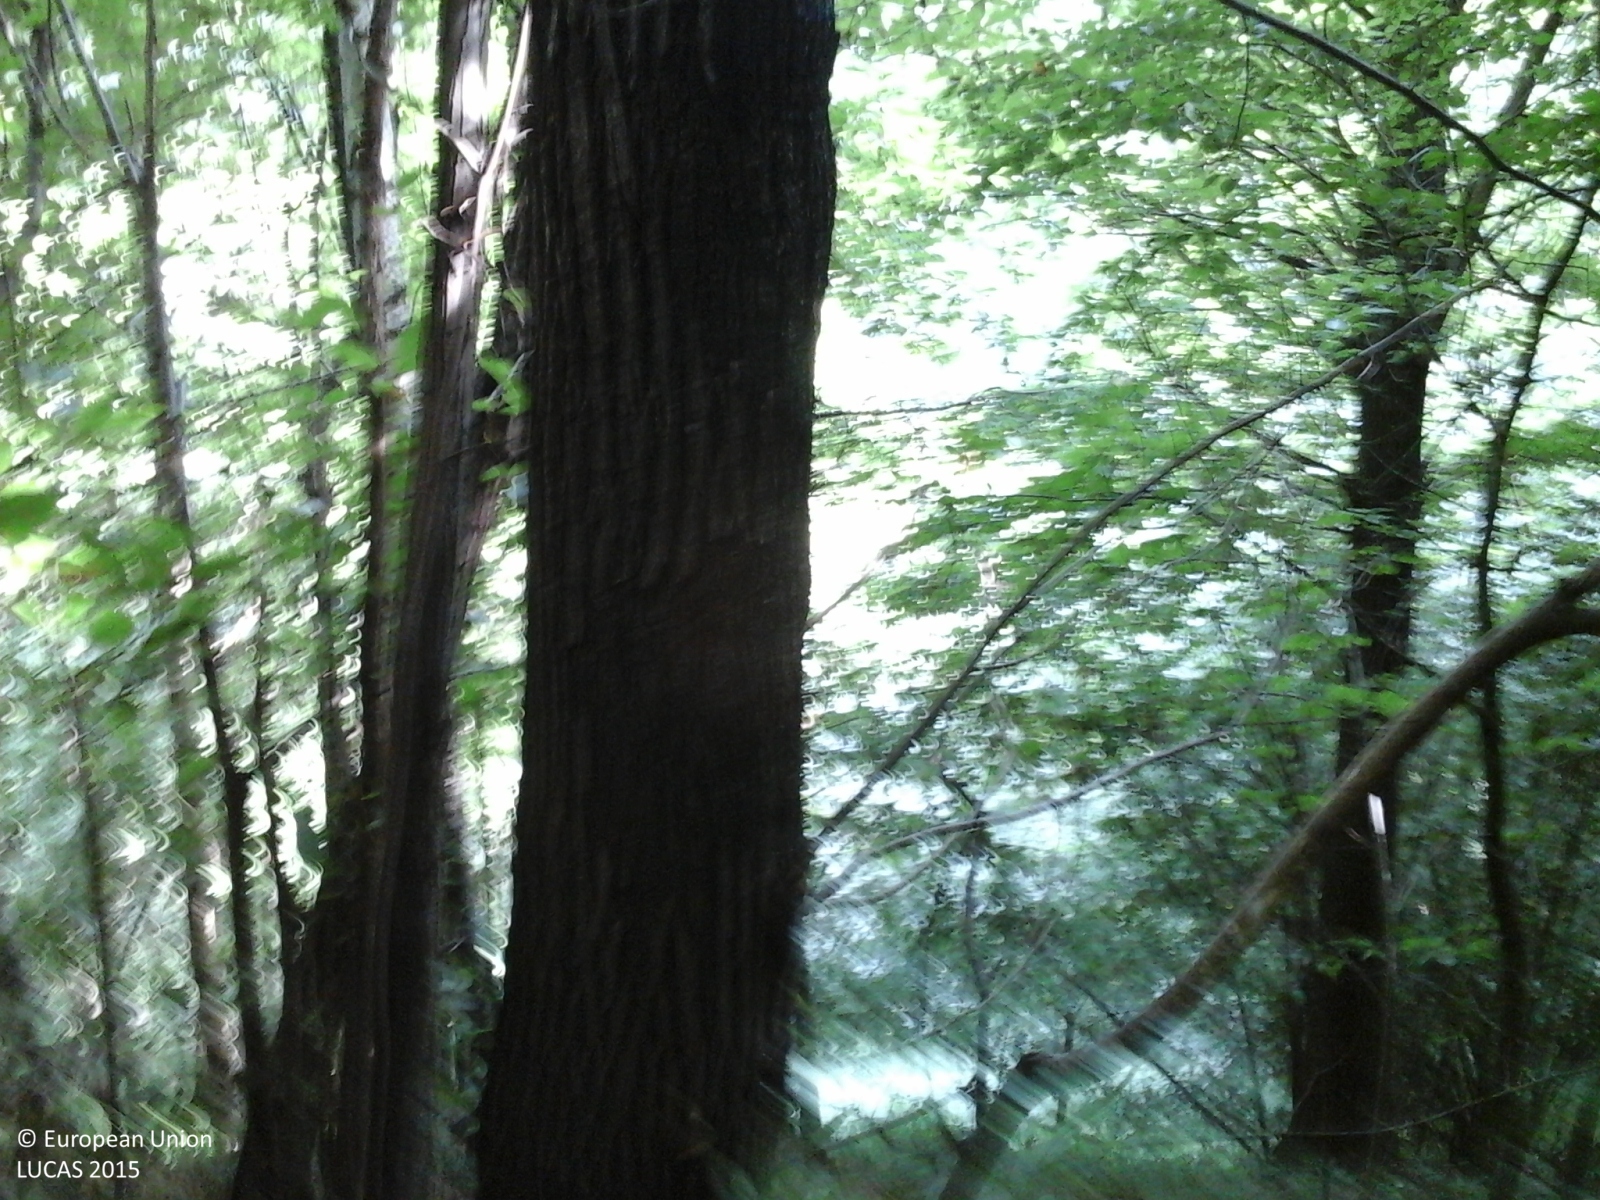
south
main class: Woodland
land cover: Broadleaved woodland
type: thermophilous deciduous forest
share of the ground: > 75 %
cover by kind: broadleaved forest trees 90 %, shrubs 10 %
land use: Forestry
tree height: > 5 m
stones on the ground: < 10 %
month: June
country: IT
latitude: 44.5867
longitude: 7.3224
